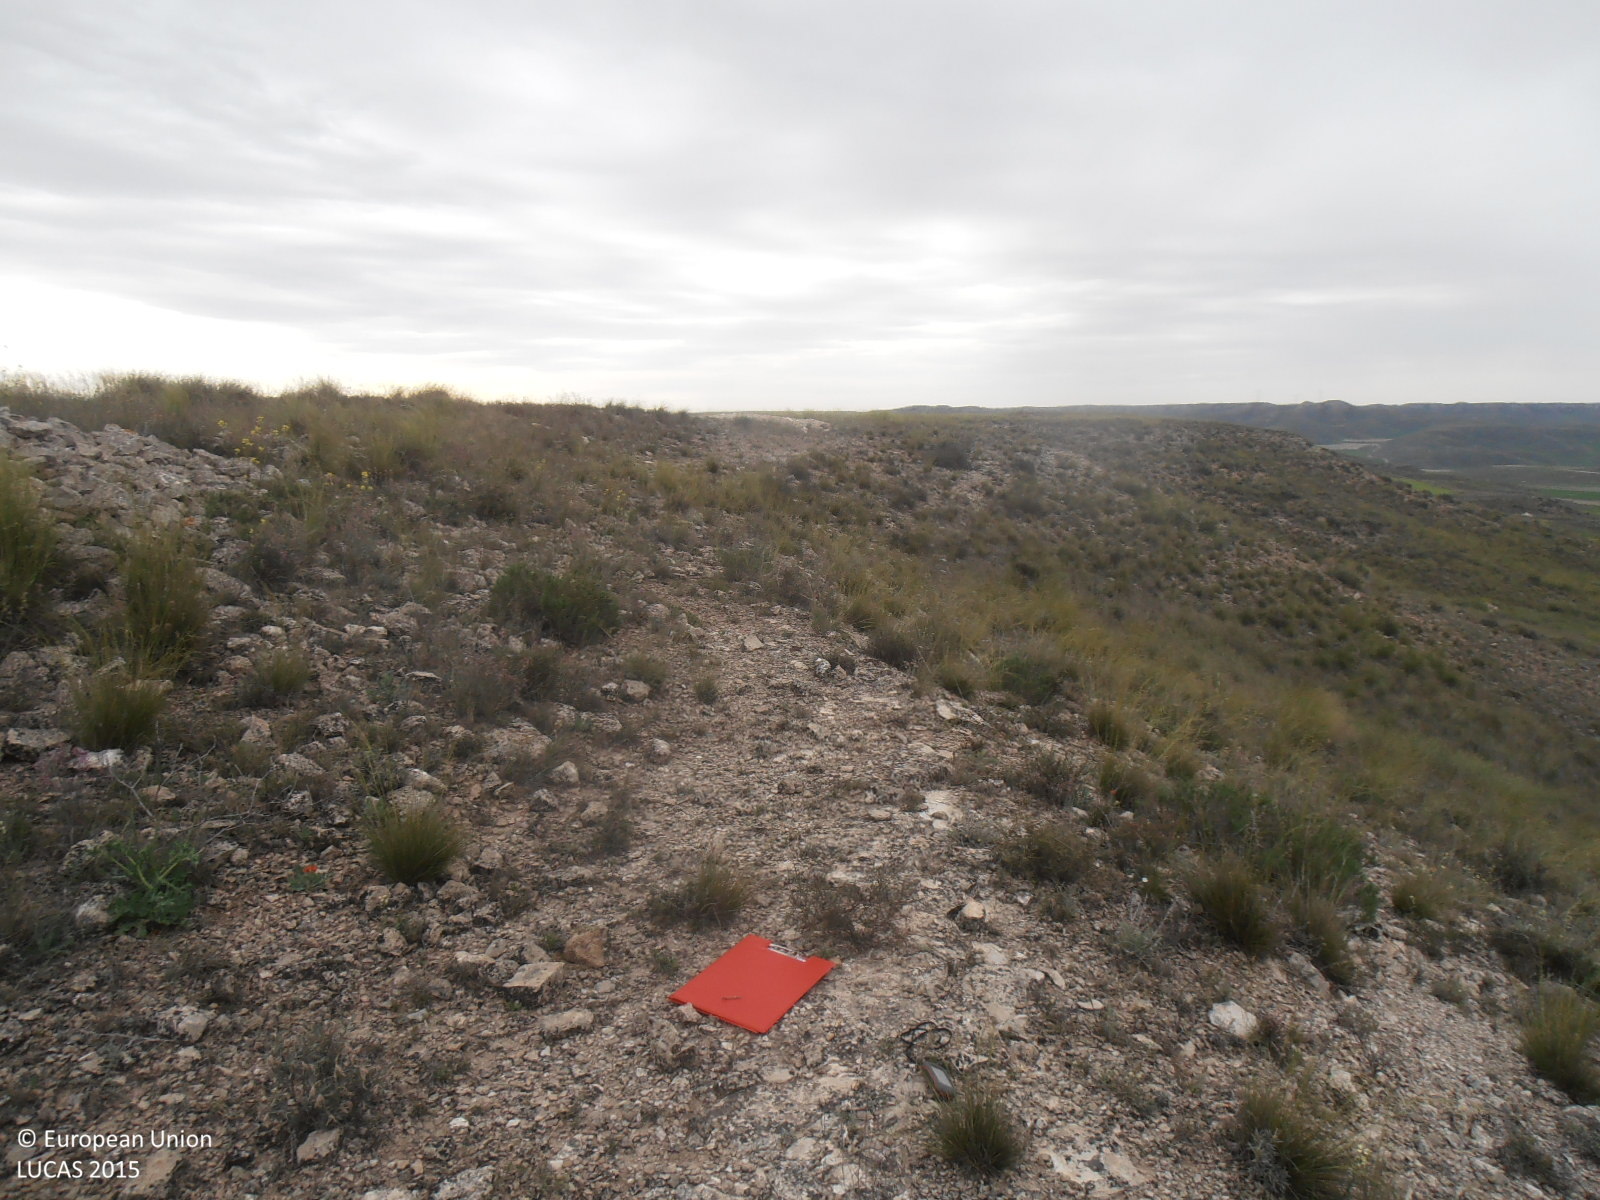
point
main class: Grassland
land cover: Grassland without tree/shrub cover
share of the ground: > 75 %
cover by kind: herbaceous plants 65 %, consolidated bare surface 30 %, shrubs 5 %
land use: Semi-natural and natural areas not in use
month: April
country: ES
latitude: 41.4087
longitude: -0.3878
